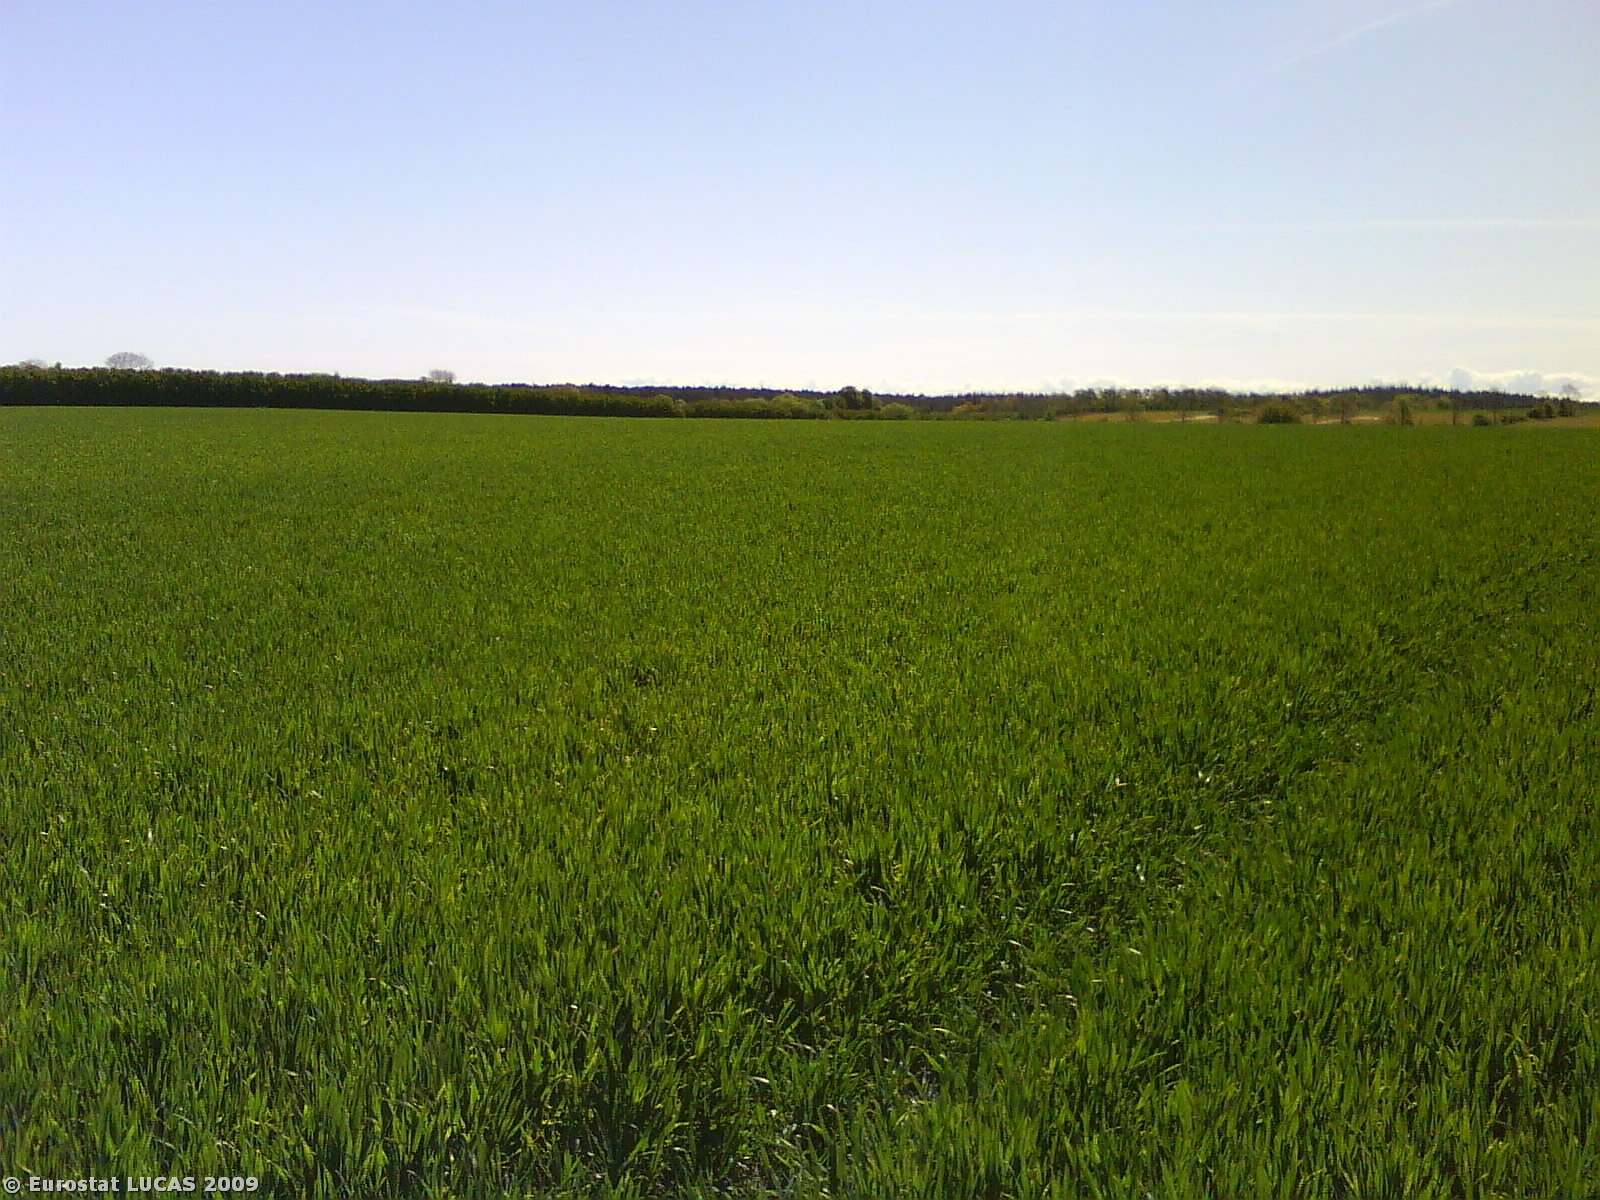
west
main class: Cropland
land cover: Common wheat
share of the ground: > 75 %
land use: Agriculture (excluding fallow land and kitchen gardens)
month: May
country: DK
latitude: 56.3824
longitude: 10.8896
